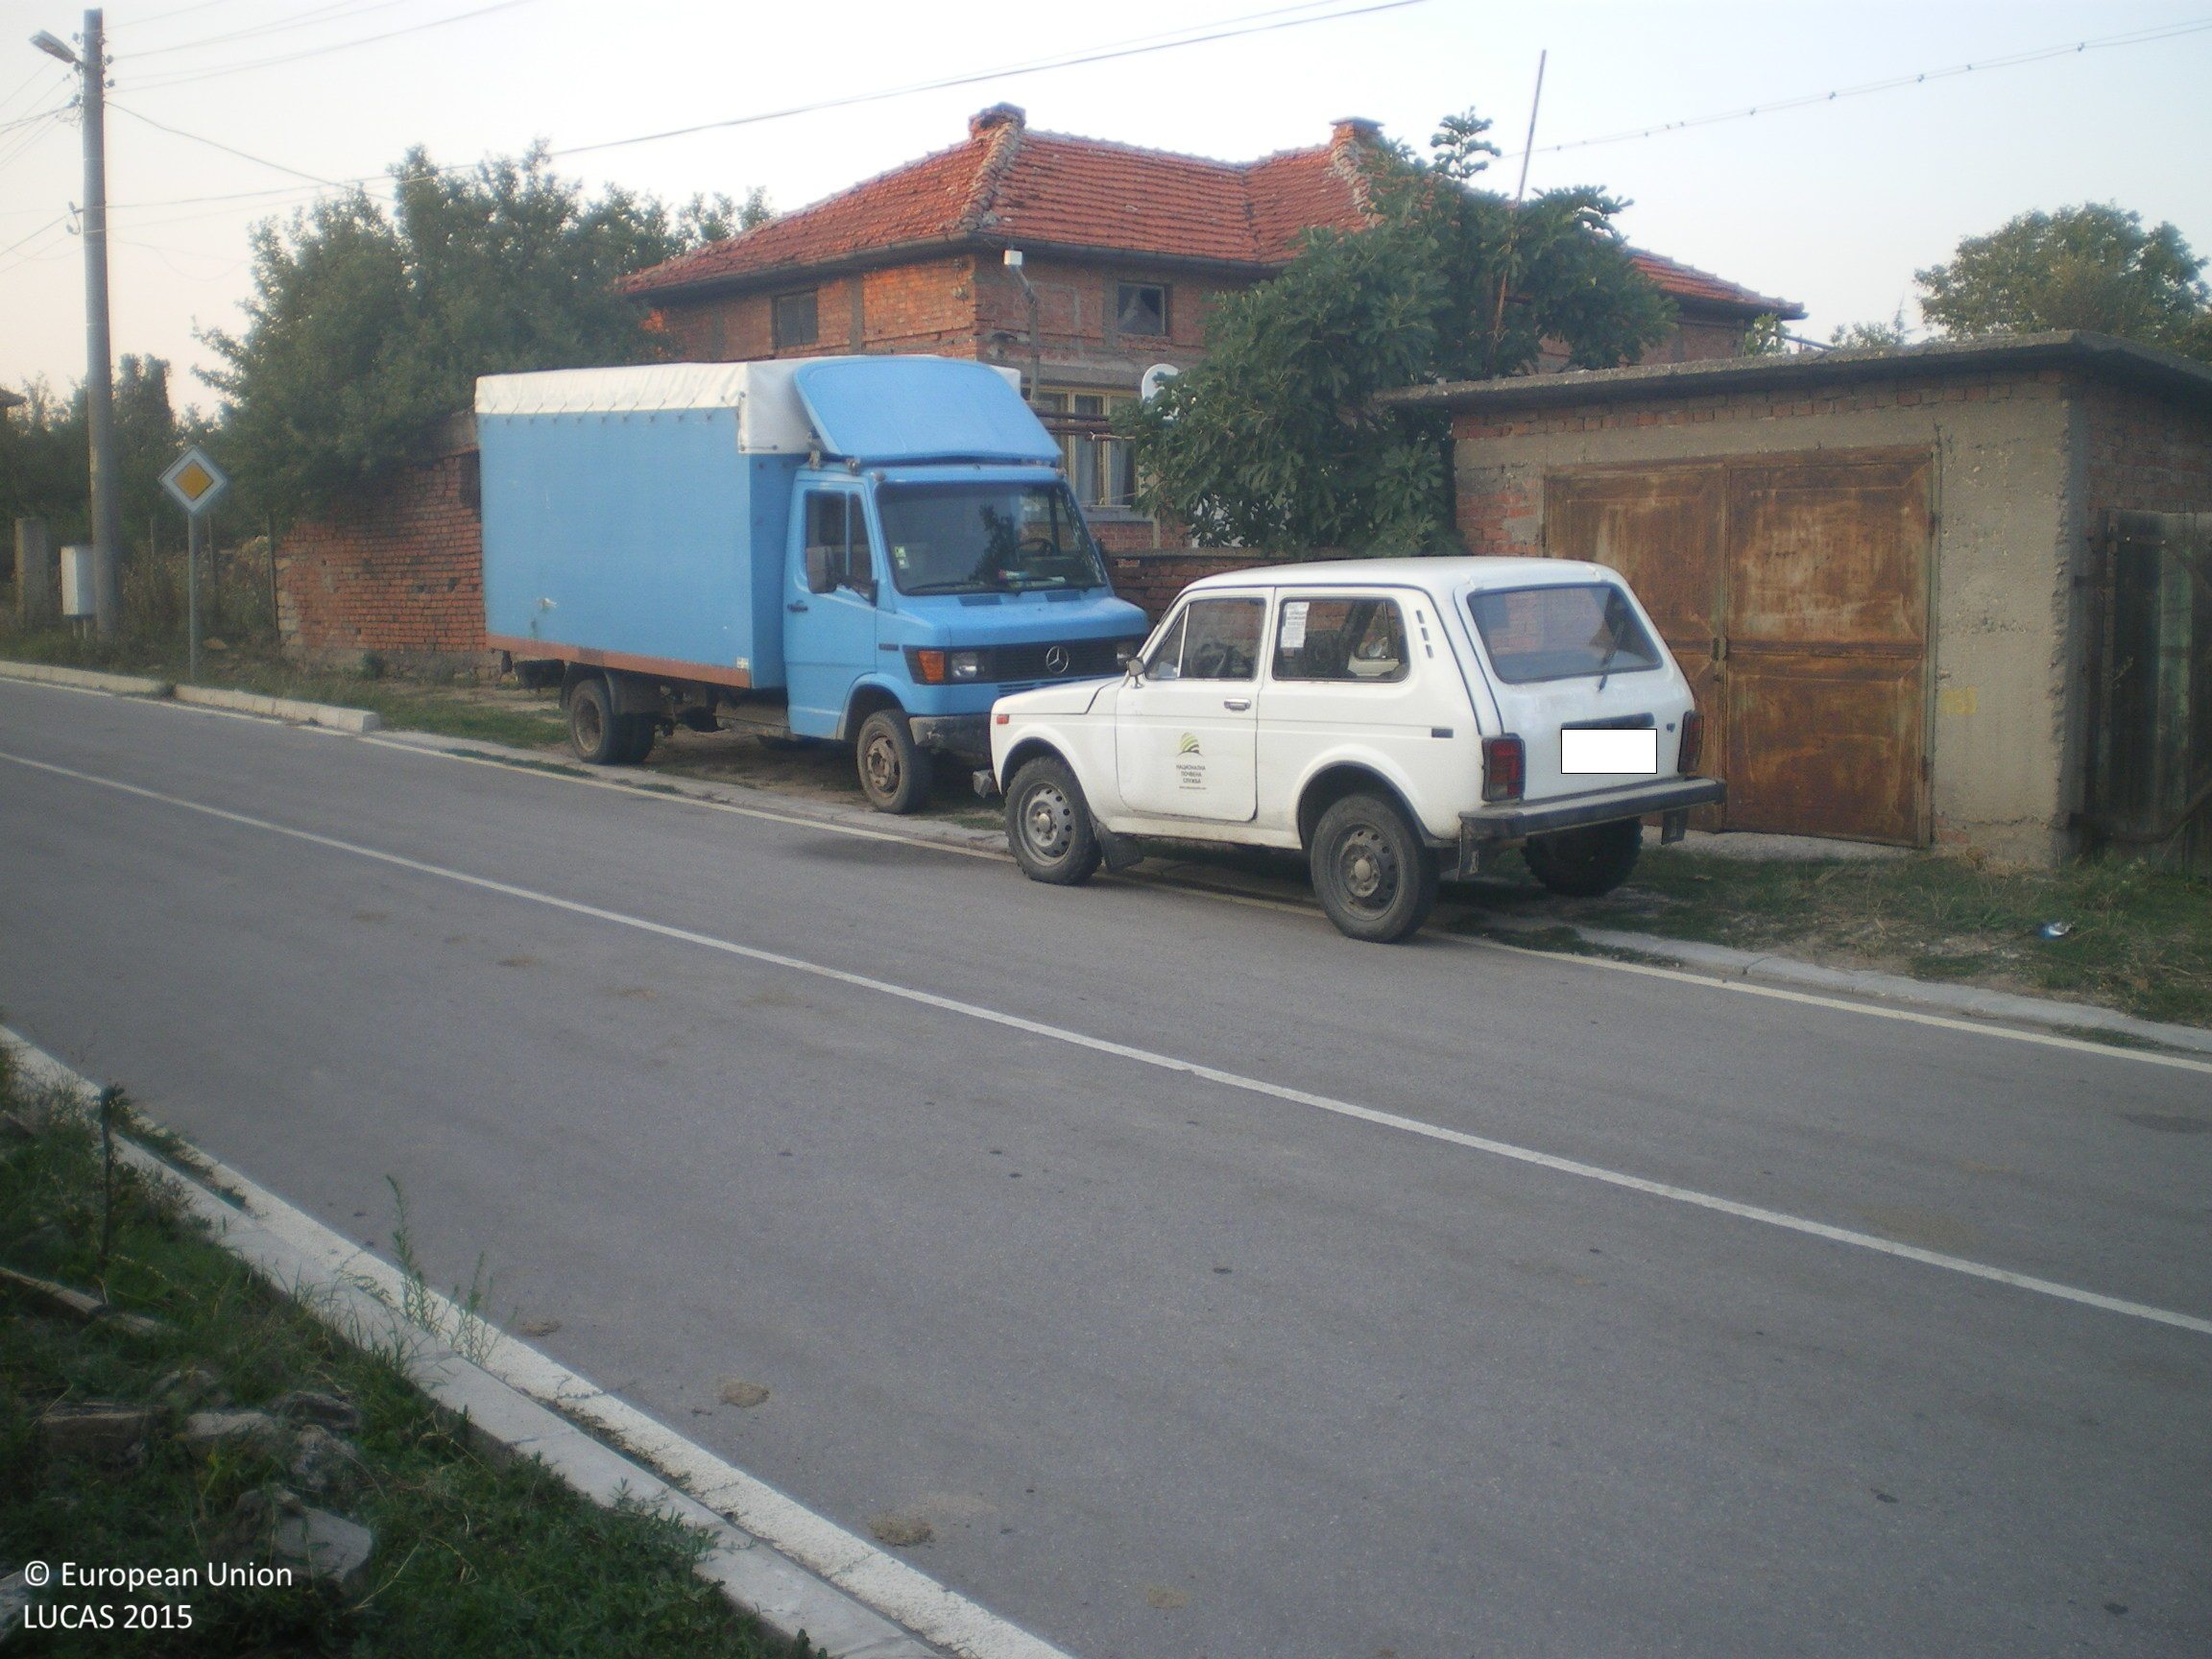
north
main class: Grassland
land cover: Grassland with sparse tree/shrub cover
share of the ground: > 75 %
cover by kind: herbaceous plants 85 %, shrubs 10 %, broadleaved forest trees 5 %
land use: Residential
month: August
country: BG
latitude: 41.9713
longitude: 25.8181
